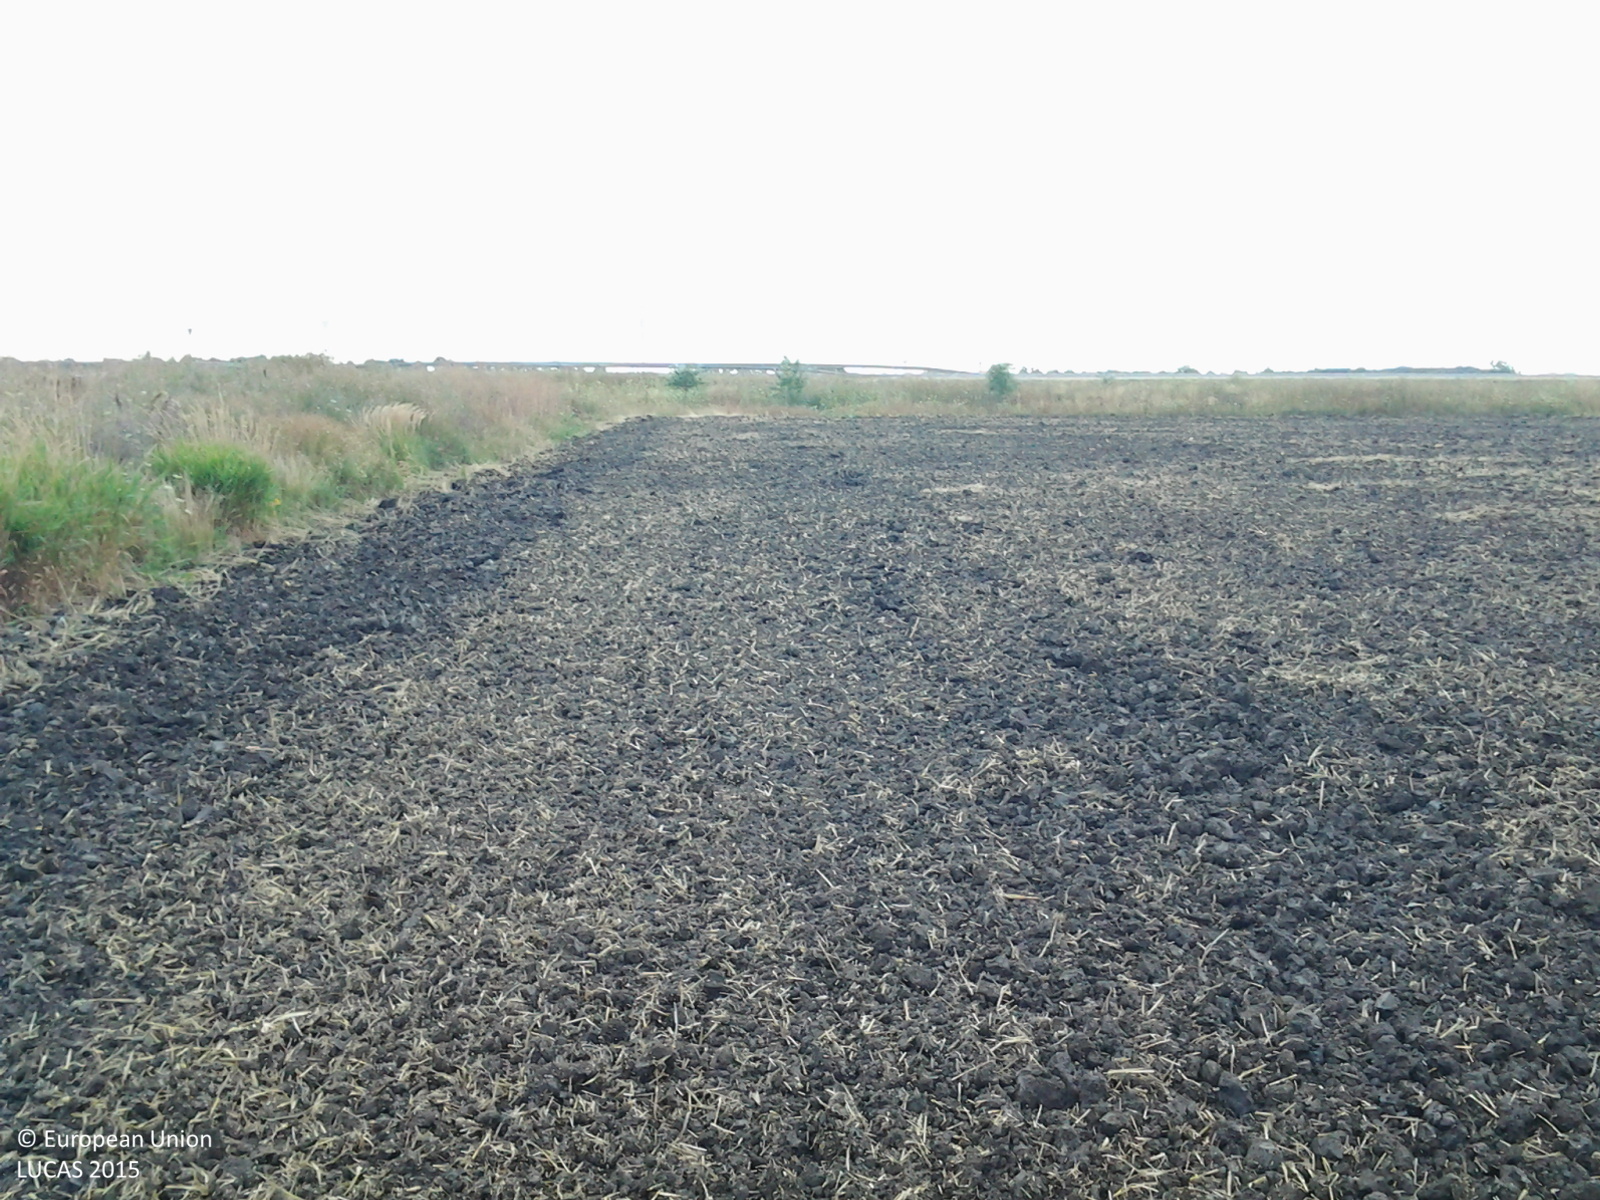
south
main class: Cropland
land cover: Common wheat
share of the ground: < 10 %
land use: Agriculture (excluding fallow land and kitchen gardens)
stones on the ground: < 10 %
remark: Harvested field
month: July
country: HU
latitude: 47.2402
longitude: 20.7729
